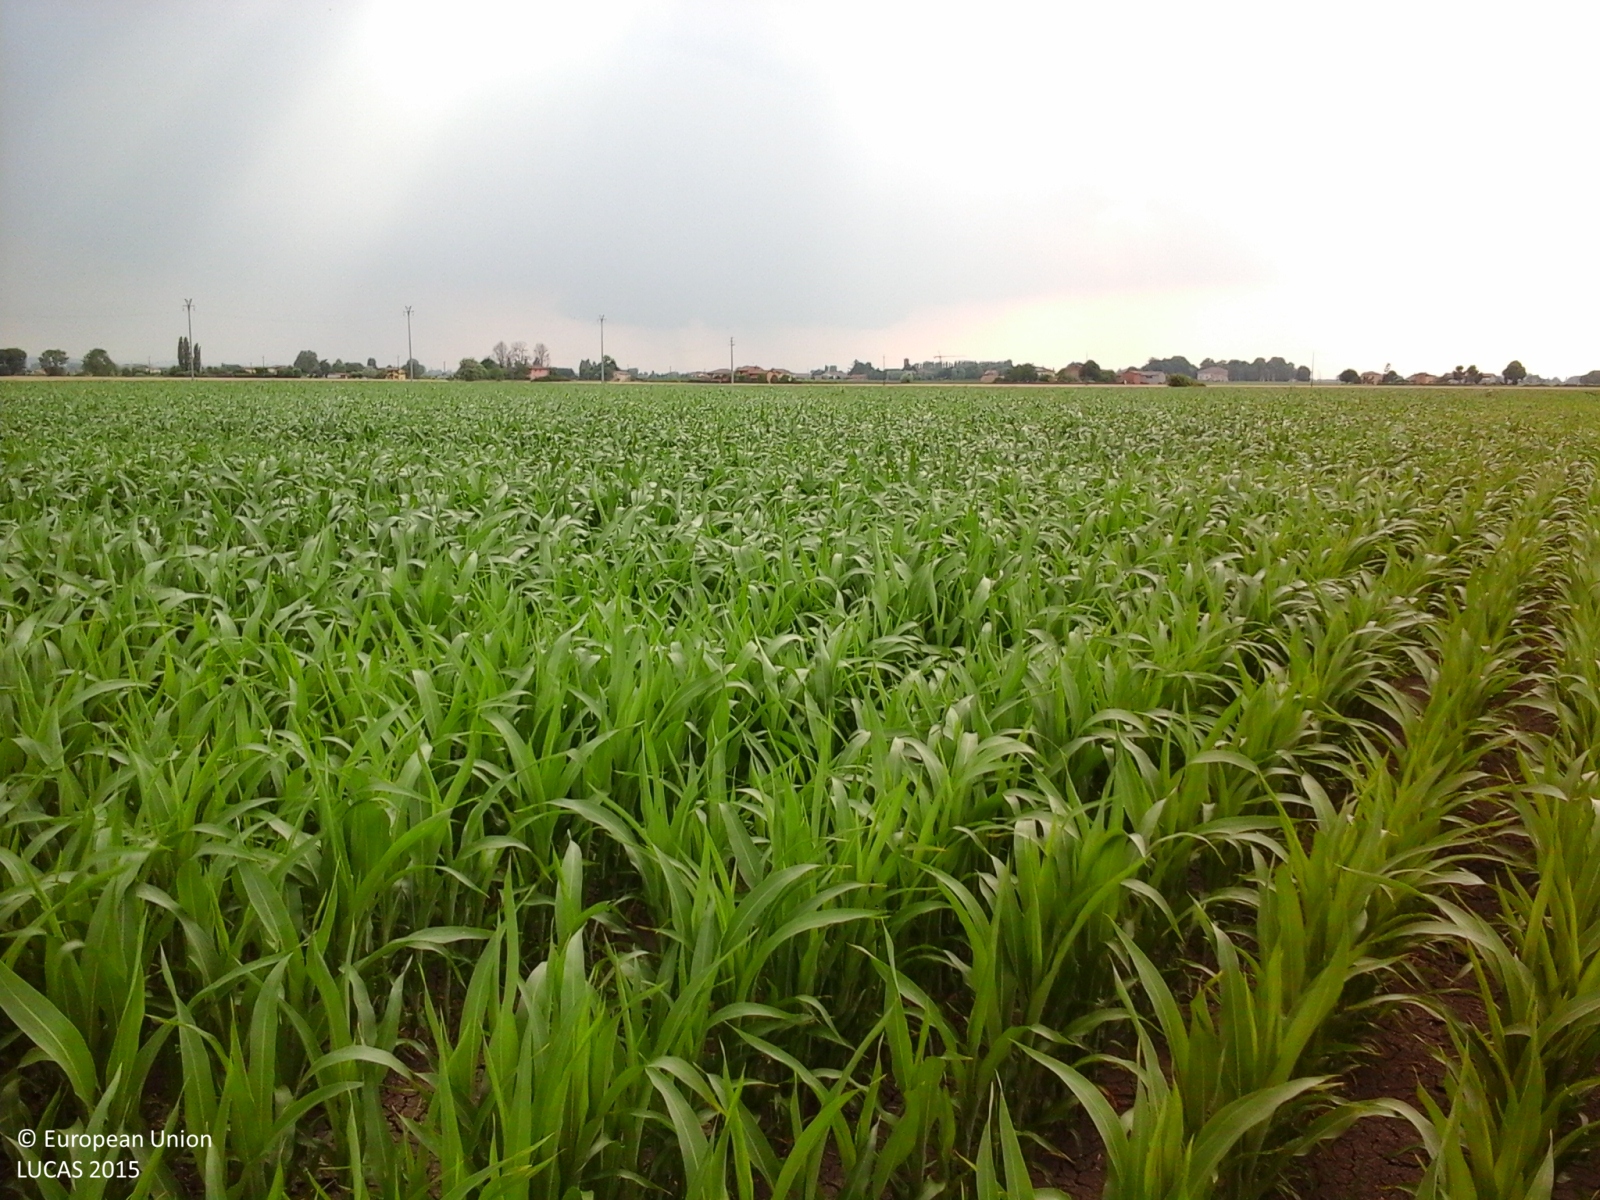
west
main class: Cropland
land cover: Other cereals
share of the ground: > 75 %
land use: Agriculture (excluding fallow land and kitchen gardens)
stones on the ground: < 10 %
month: May
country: IT
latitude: 44.5548
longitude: 11.5954
